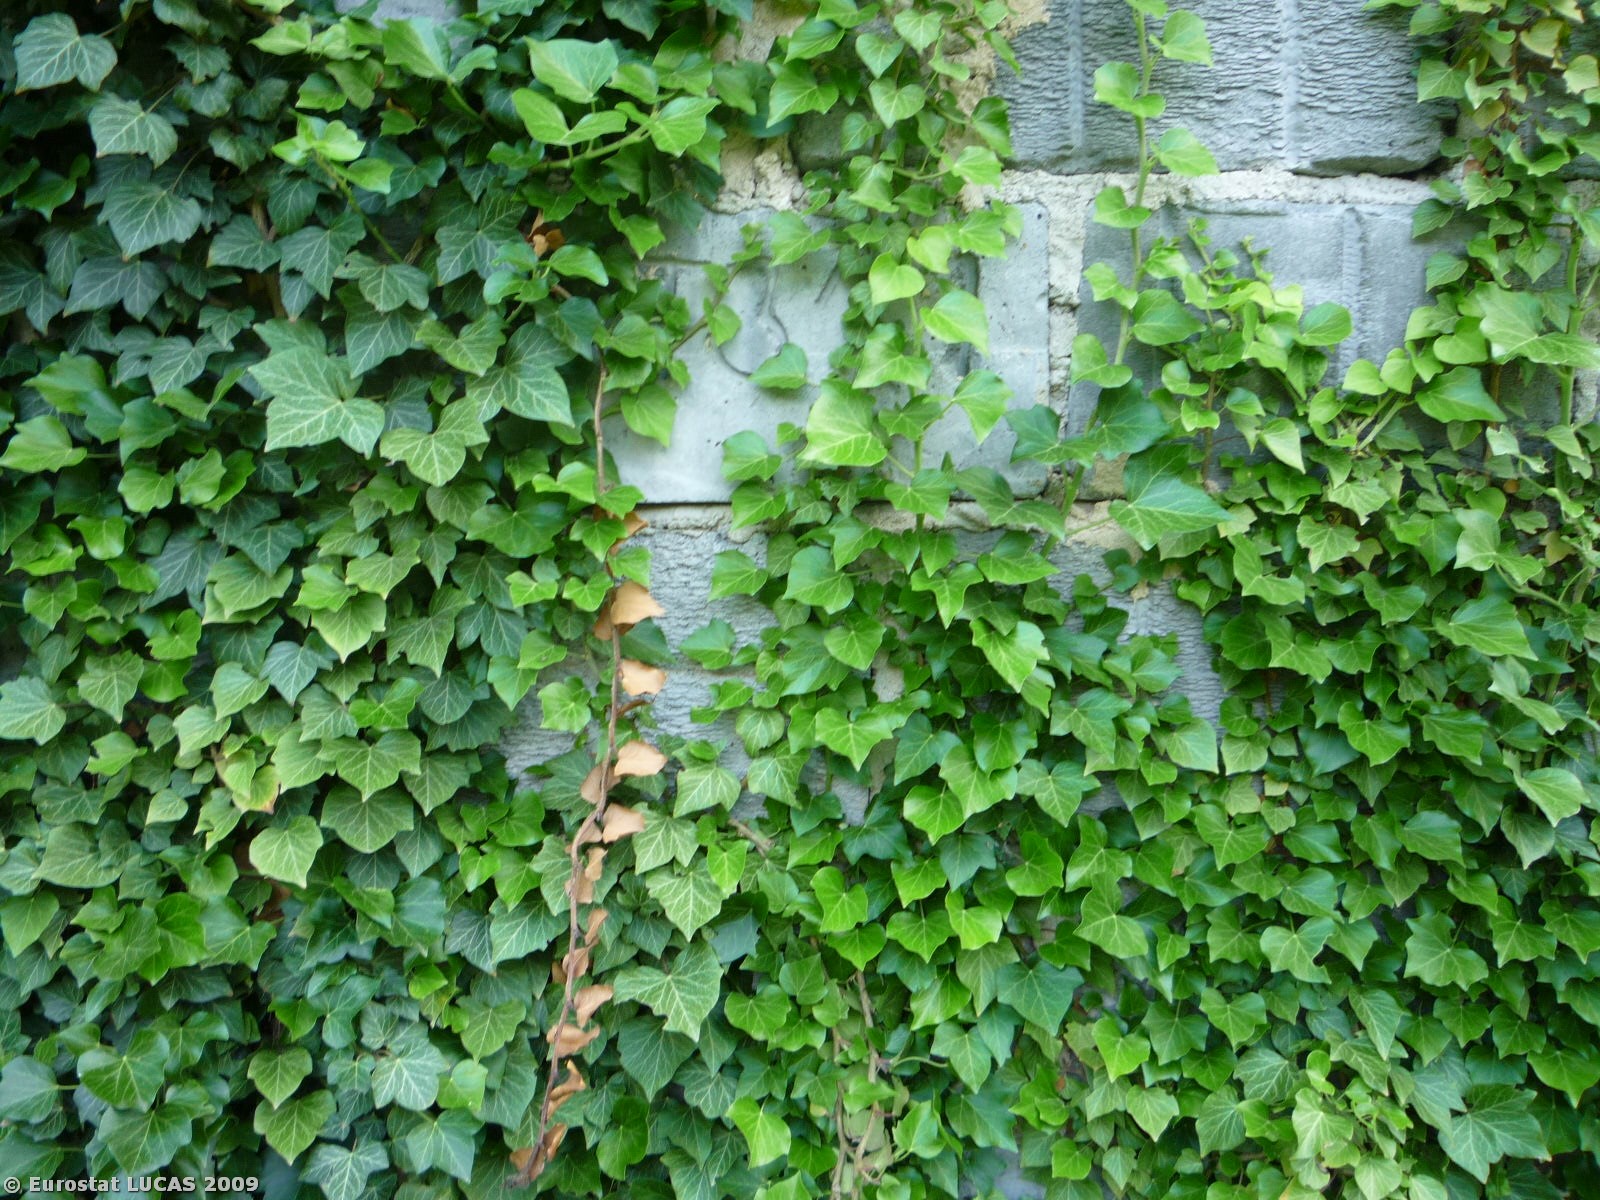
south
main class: Grassland
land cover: Grassland without tree/shrub cover
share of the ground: > 75 %
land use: Residential
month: June
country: CZ
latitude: 50.3261
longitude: 15.0175
